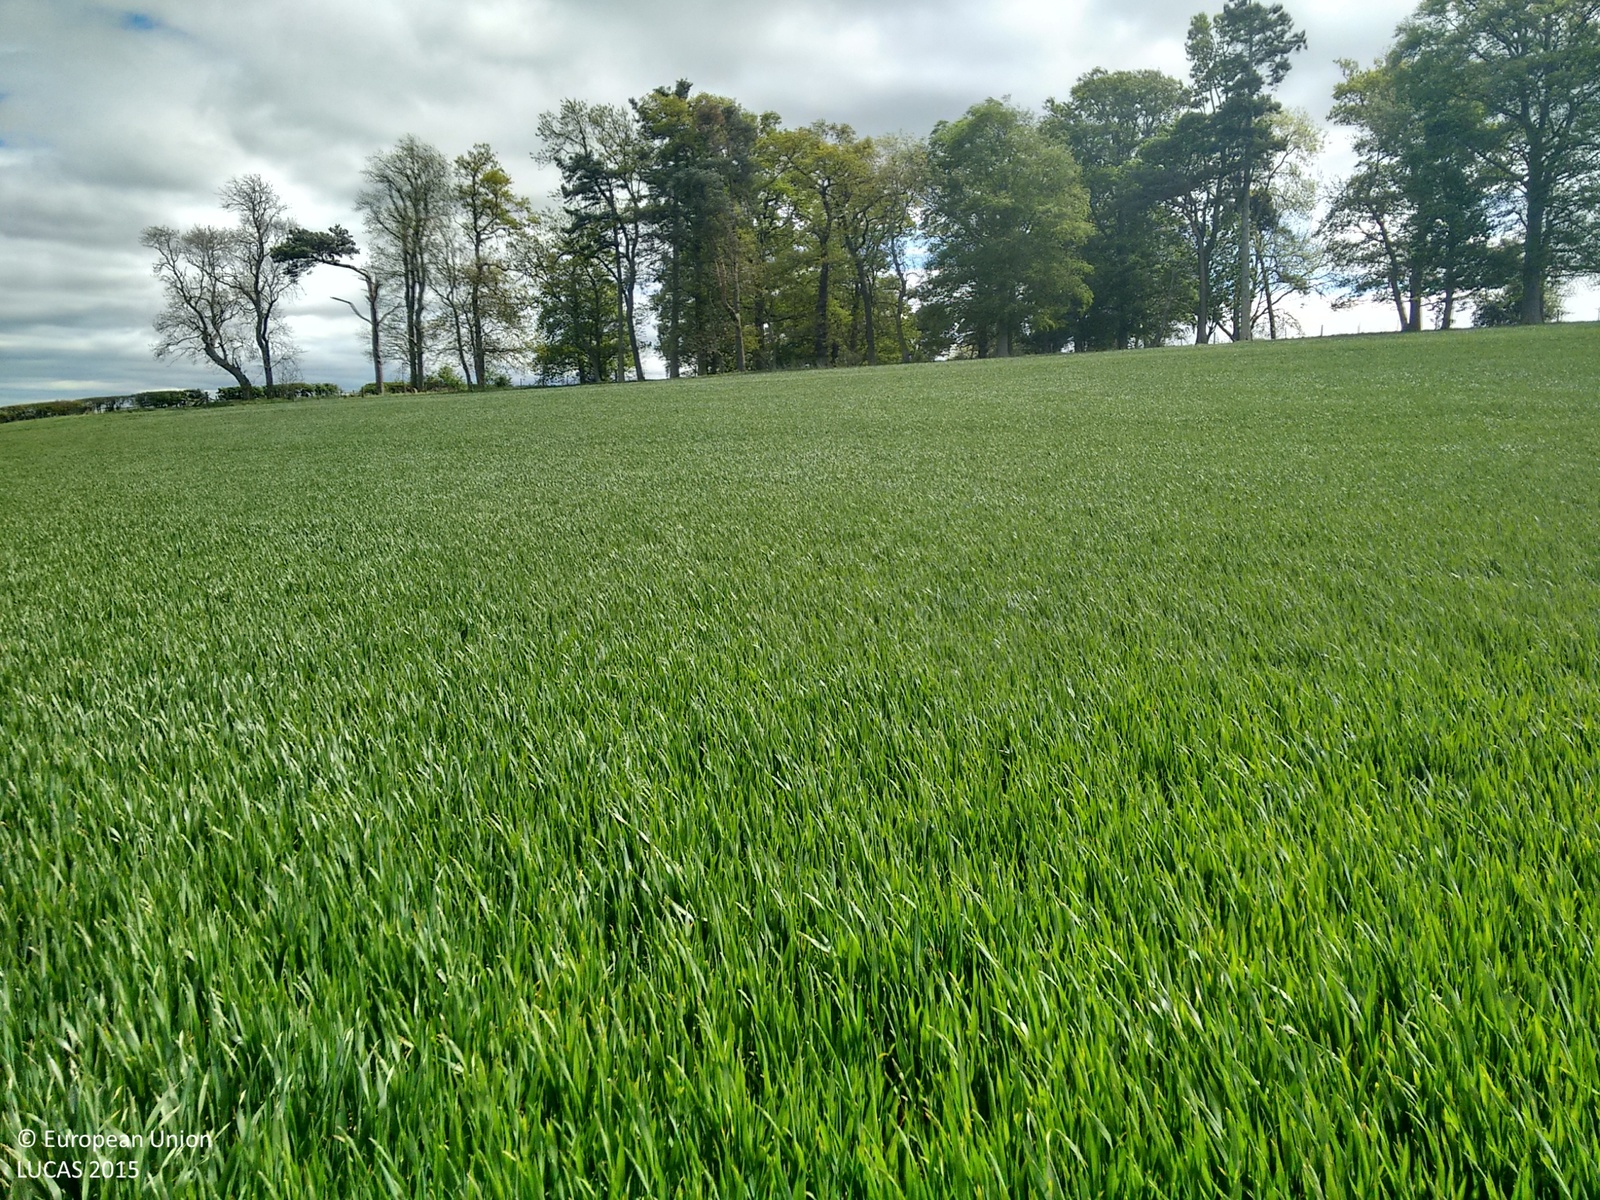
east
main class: Cropland
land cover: Common wheat
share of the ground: > 75 %
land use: Agriculture (excluding fallow land and kitchen gardens)
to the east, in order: Common wheat; Grassland without tree/shrub cover; Fences; Other mixed woodland; Managed hedges; Fences; Barley
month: May
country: GB
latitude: 55.6409
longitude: -2.3713
